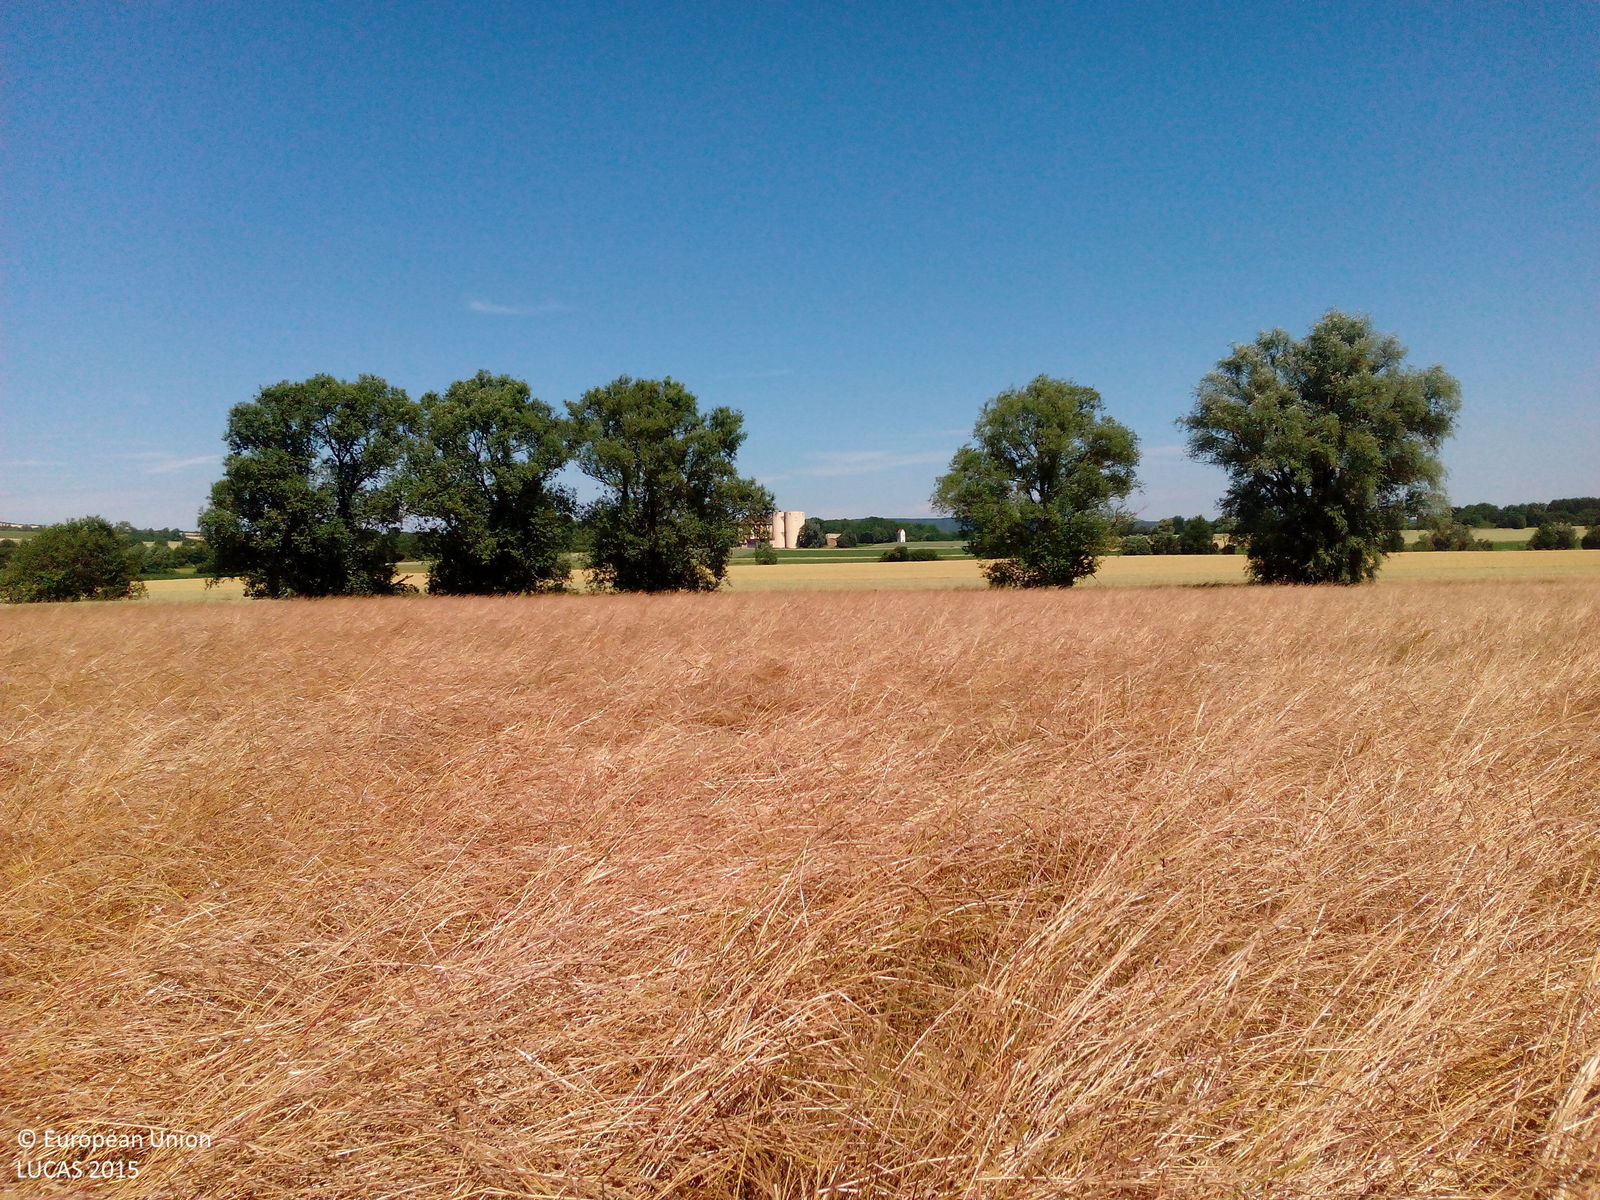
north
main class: Grassland
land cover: Grassland without tree/shrub cover
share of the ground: > 75 %
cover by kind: herbaceous plants 100 %
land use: Agriculture (excluding fallow land and kitchen gardens)
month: July
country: DE
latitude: 51.6764
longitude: 9.8699
